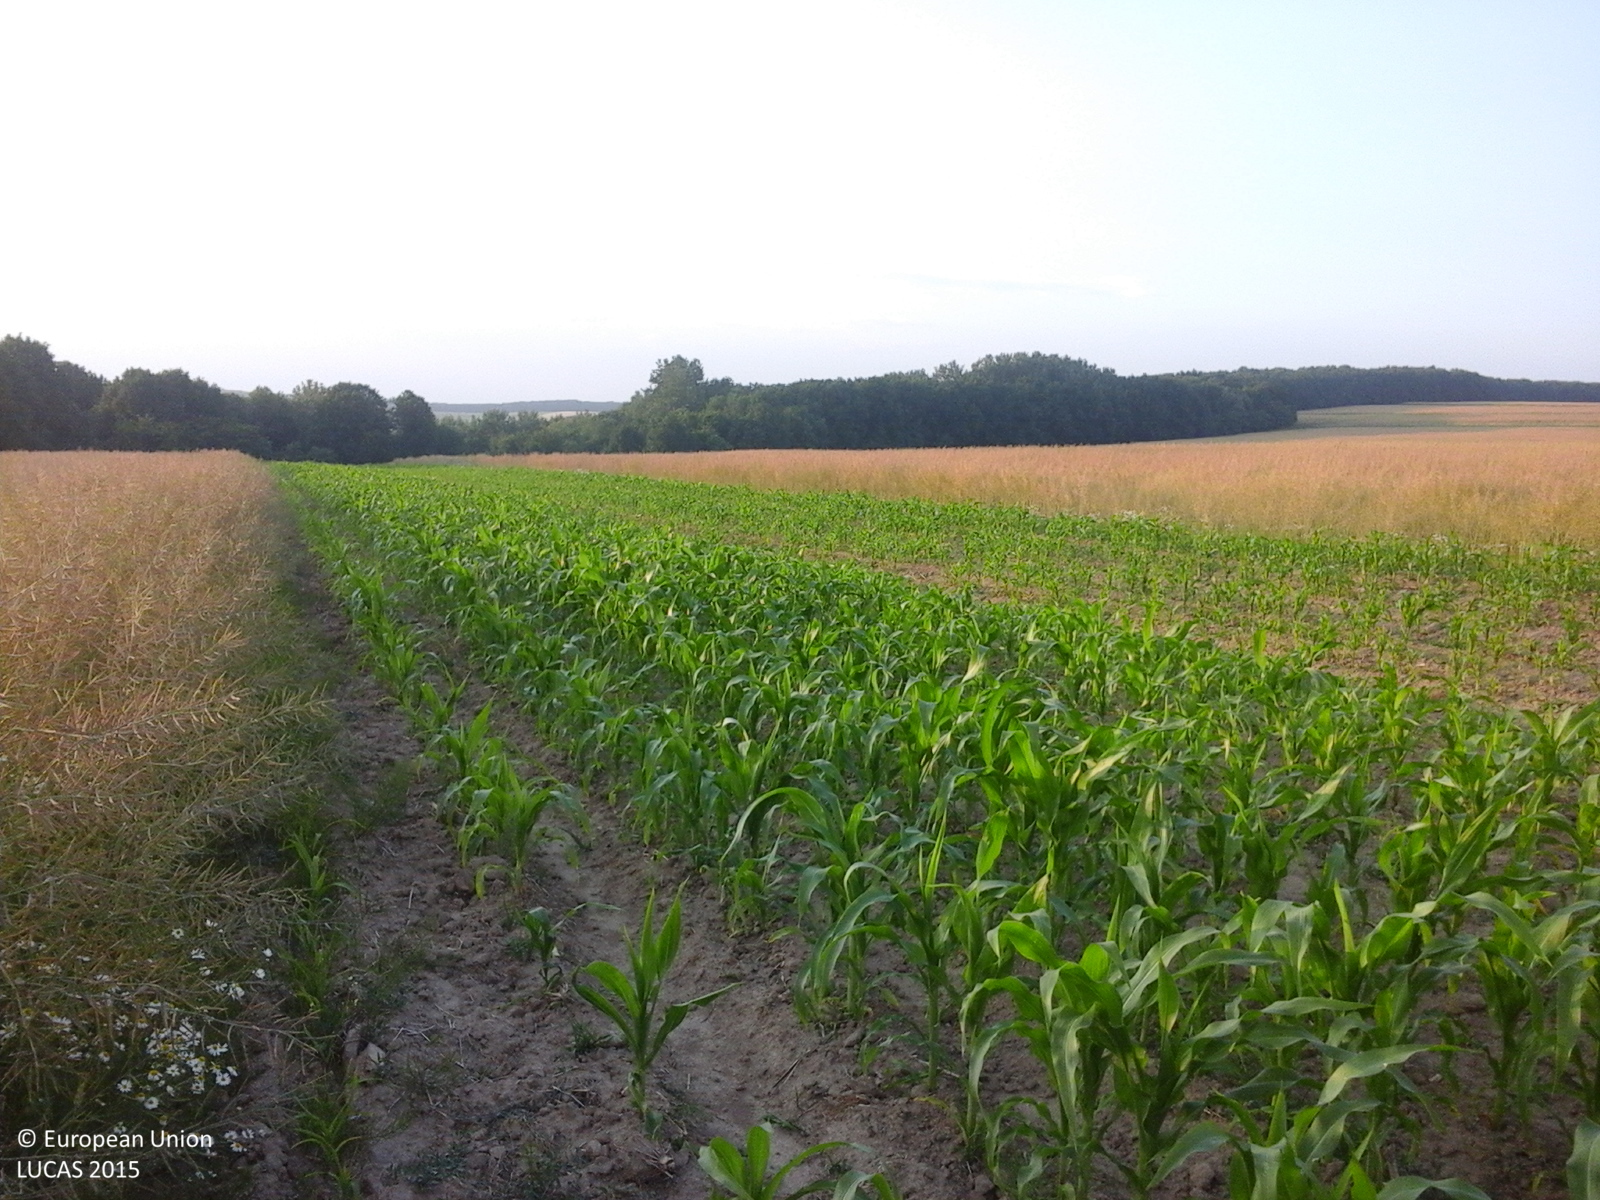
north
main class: Cropland
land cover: Rape and turnip rape
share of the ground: > 75 %
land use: Agriculture (excluding fallow land and kitchen gardens)
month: June
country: RO
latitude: 46.8095
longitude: 27.0439
